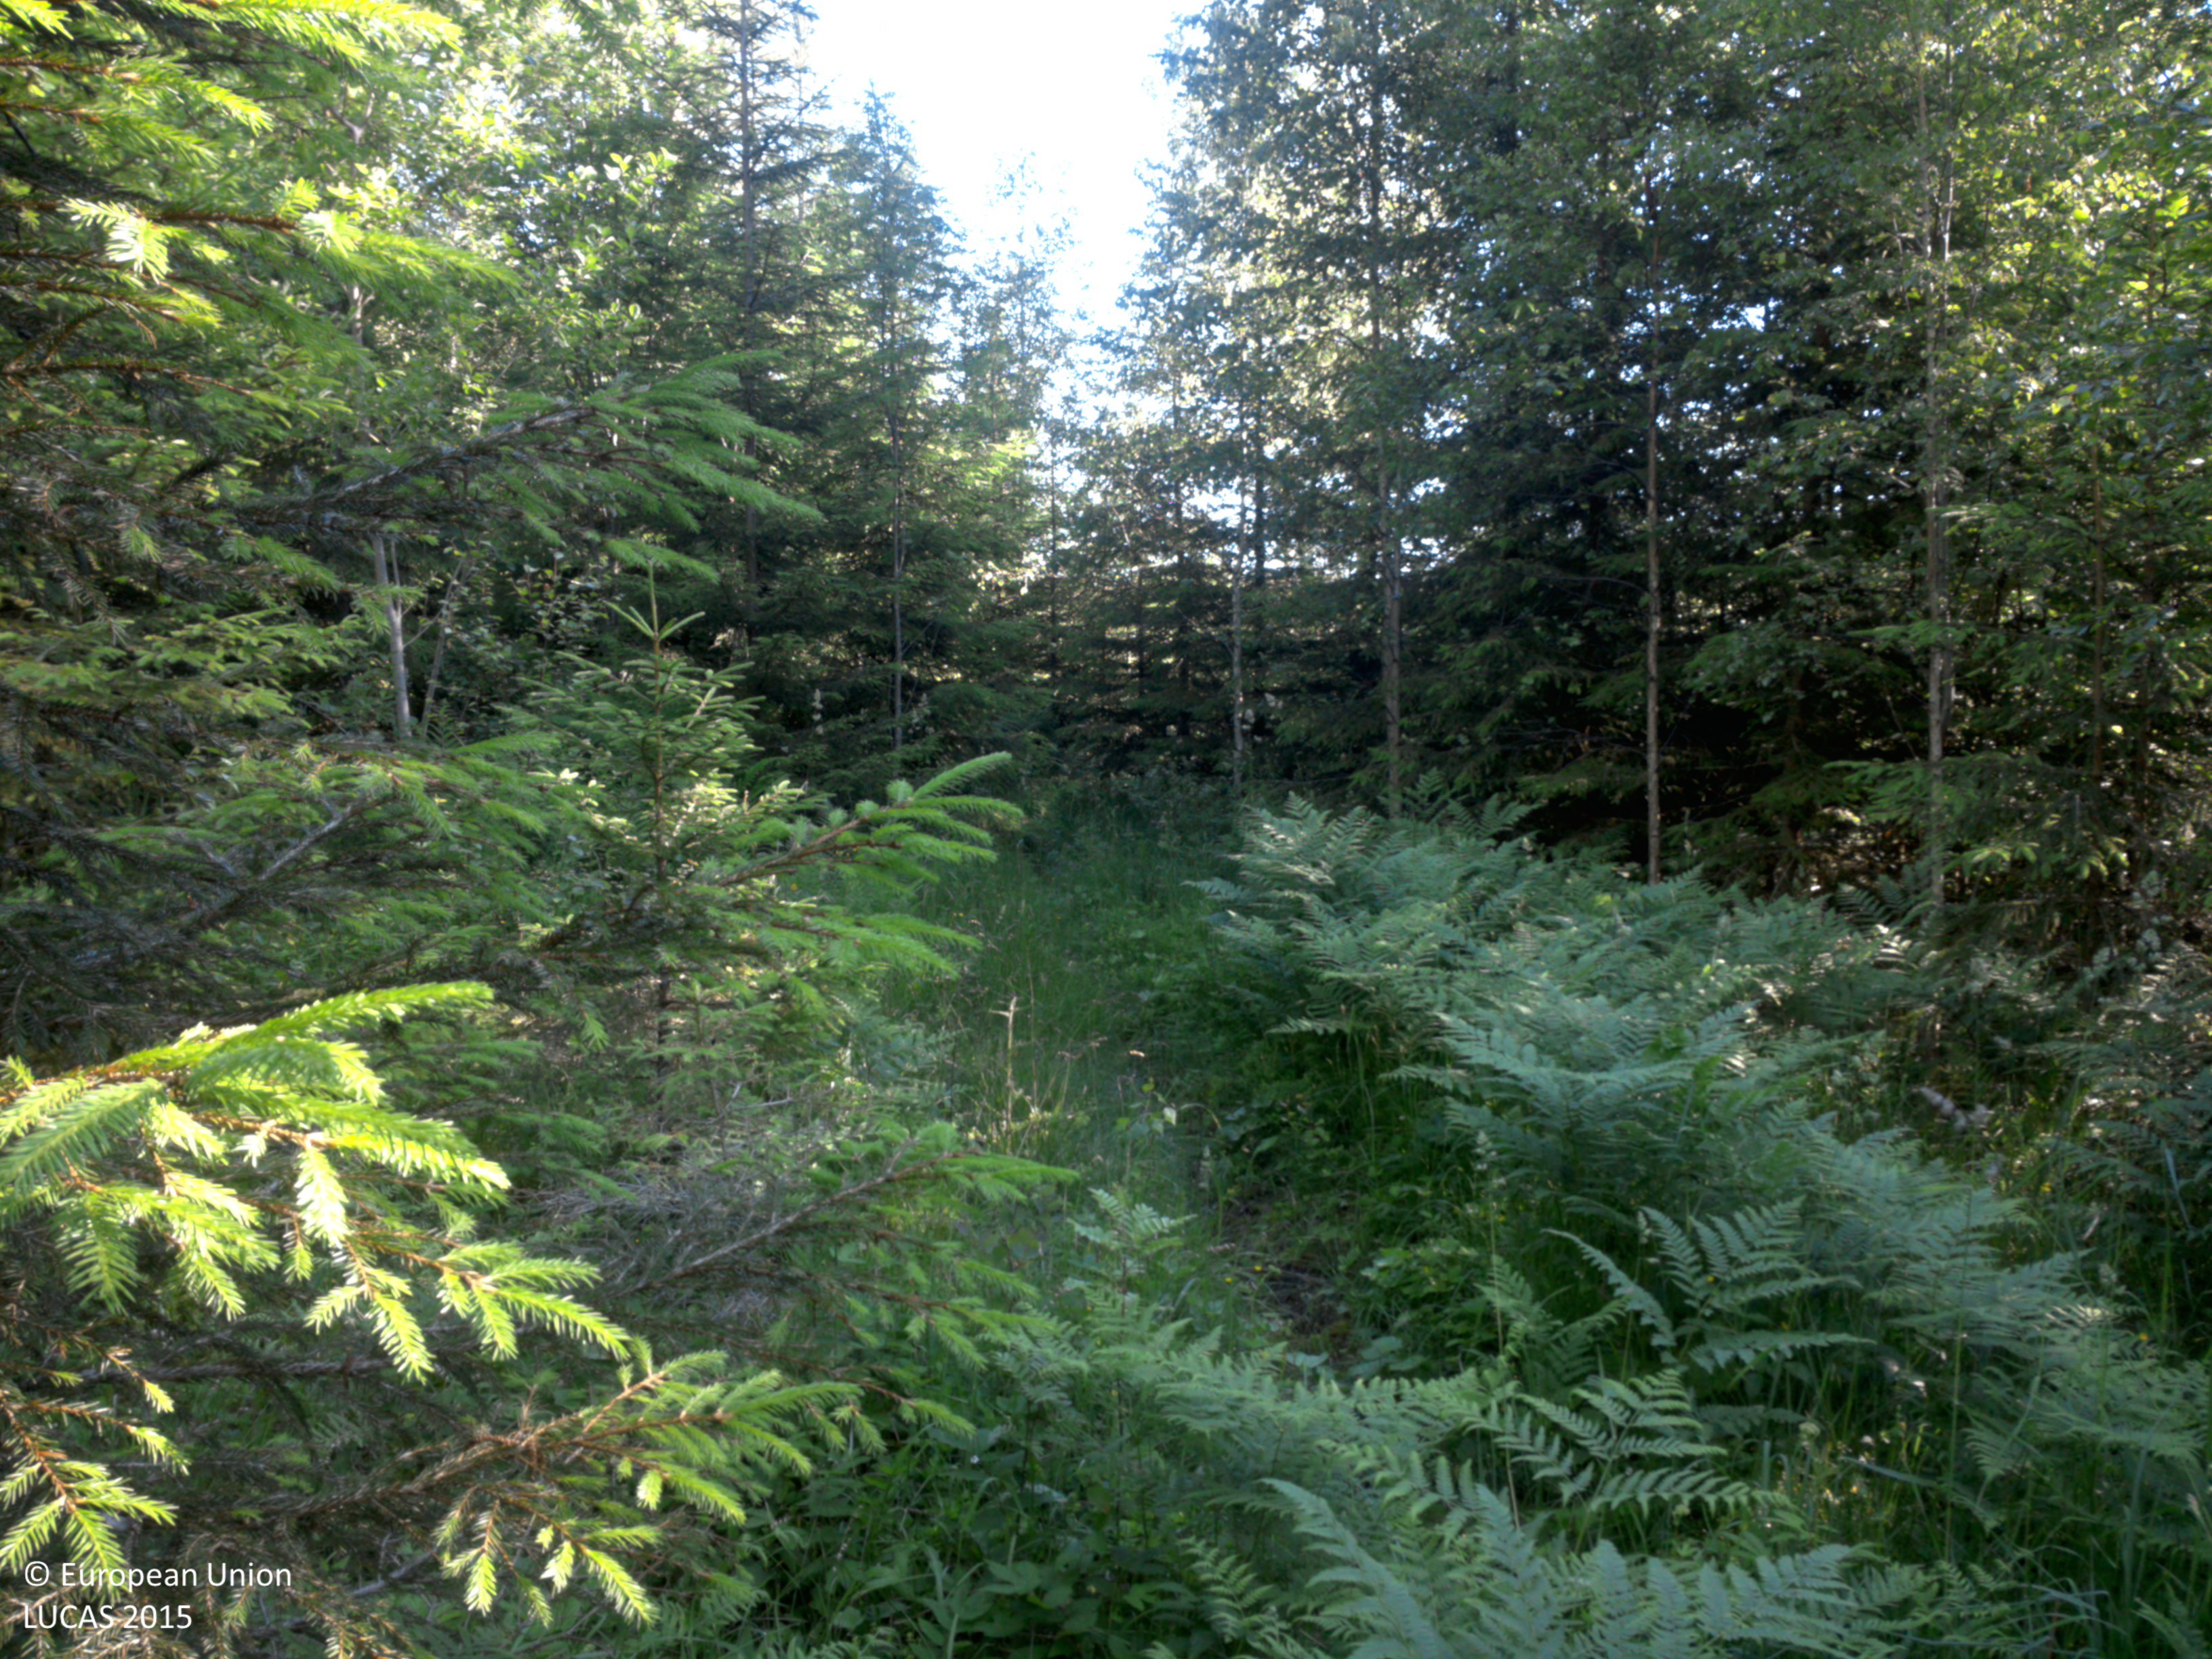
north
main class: Woodland
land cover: Spruce dominated mixed woodland
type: boreal forest
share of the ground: > 75 %
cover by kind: coniferous forest trees 60 %, broadleaved forest trees 20 %, shrubs 10 %, herbaceous plants 10 %
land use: Forestry
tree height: < 5 m
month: July
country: SE
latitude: 58.8471
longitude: 12.3345
